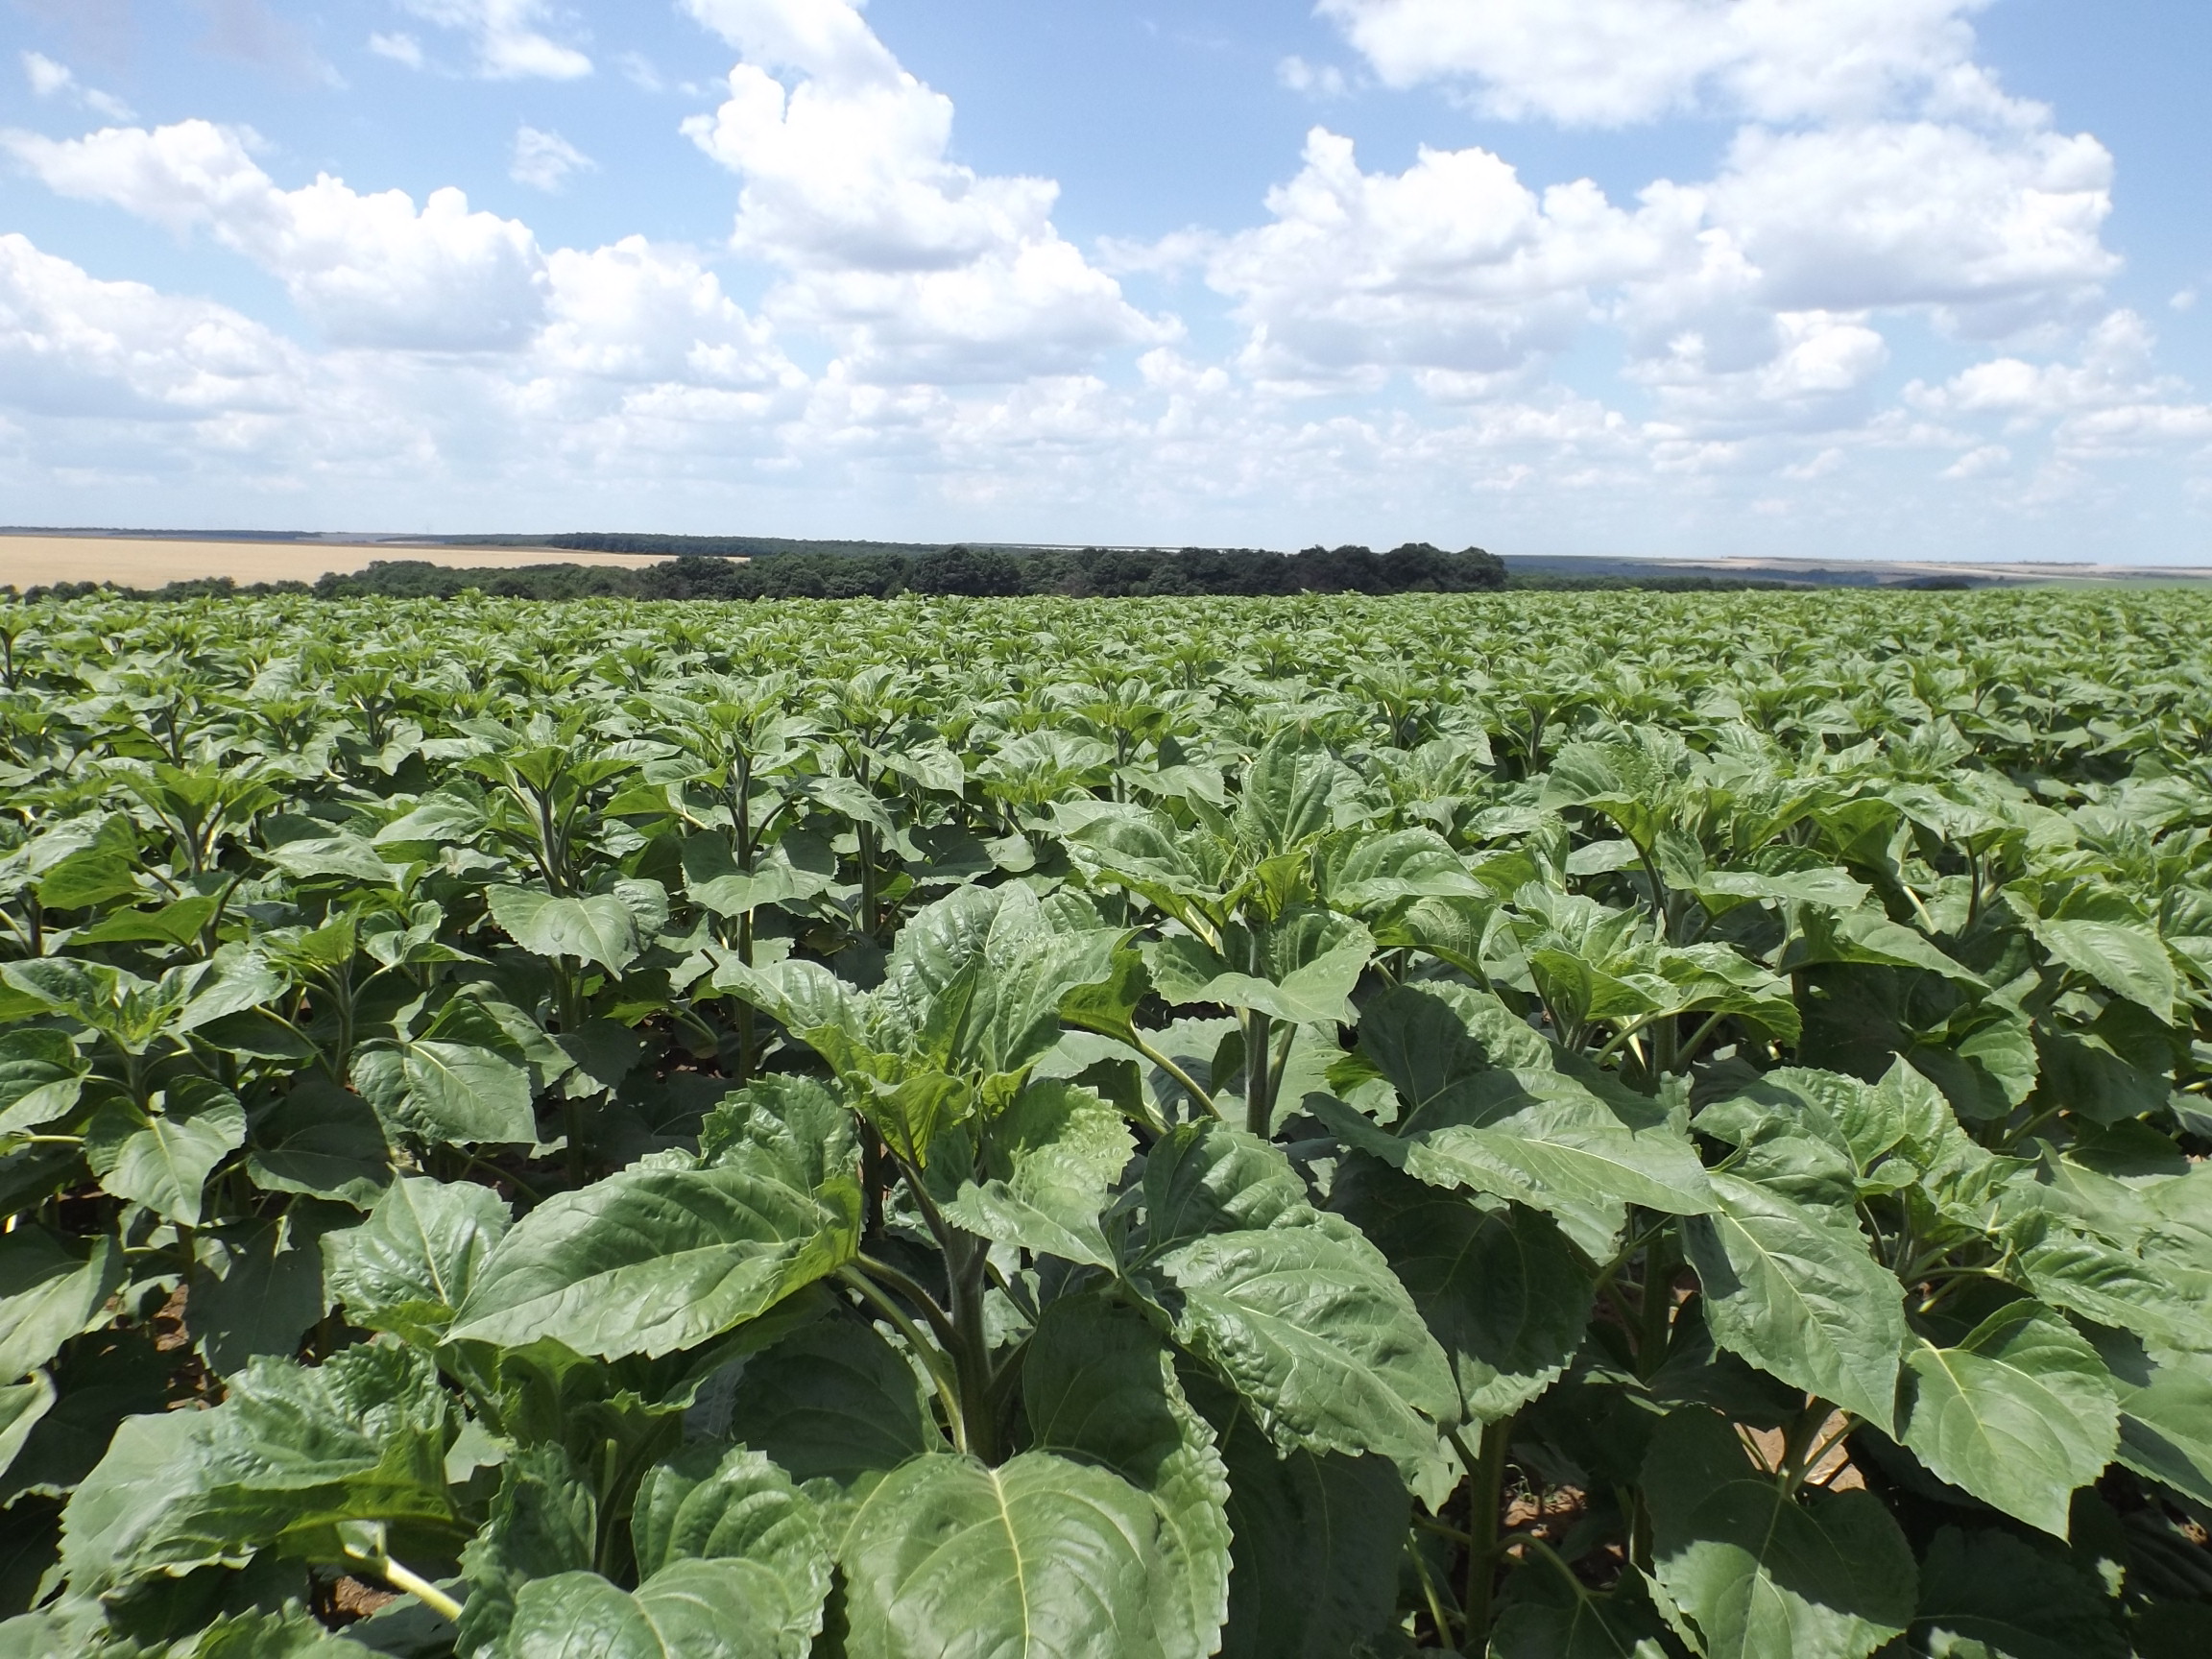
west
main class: Cropland
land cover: Sunflower
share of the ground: > 75 %
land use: Agriculture (excluding fallow land and kitchen gardens)
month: June
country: BG
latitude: 43.3943
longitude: 27.7547
